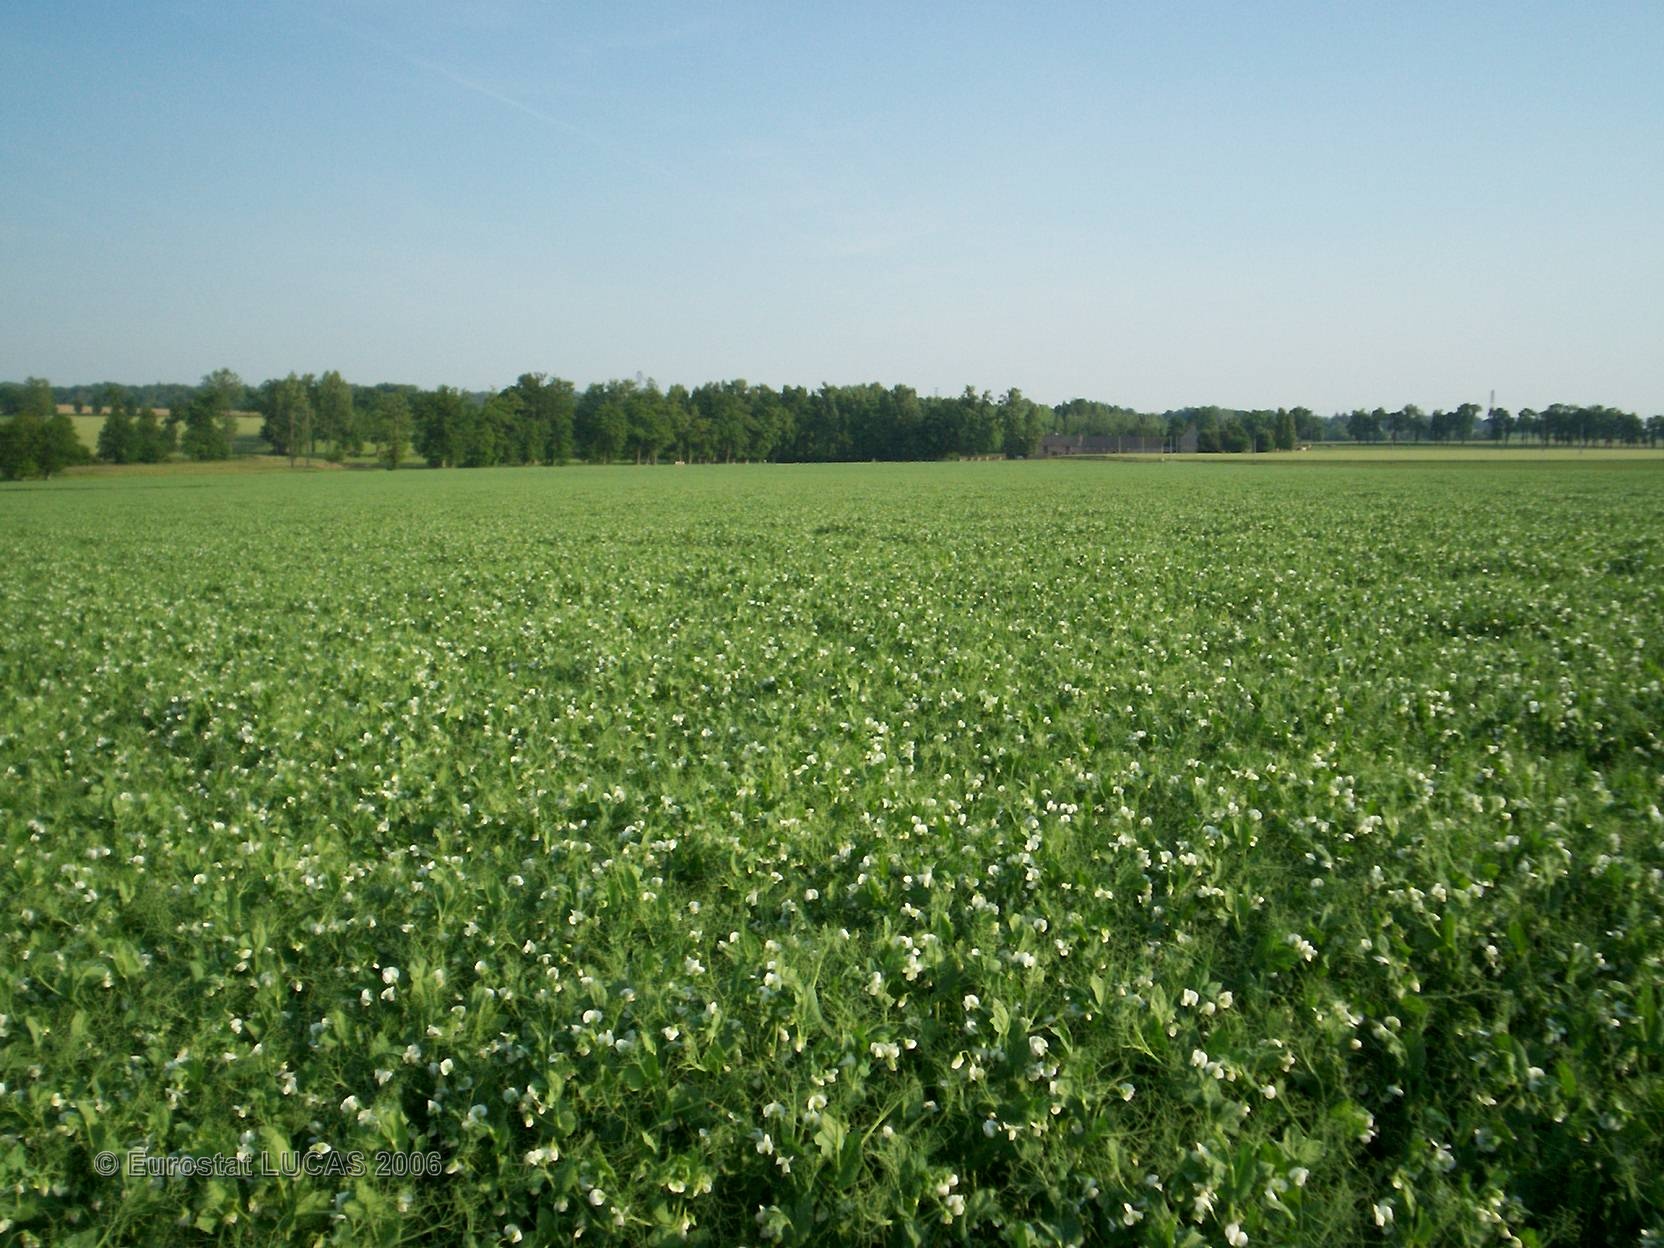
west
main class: Cropland
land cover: Barley
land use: Agriculture (excluding fallow land and kitchen gardens)
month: May
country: FR
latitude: 48.6039
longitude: -1.6444
